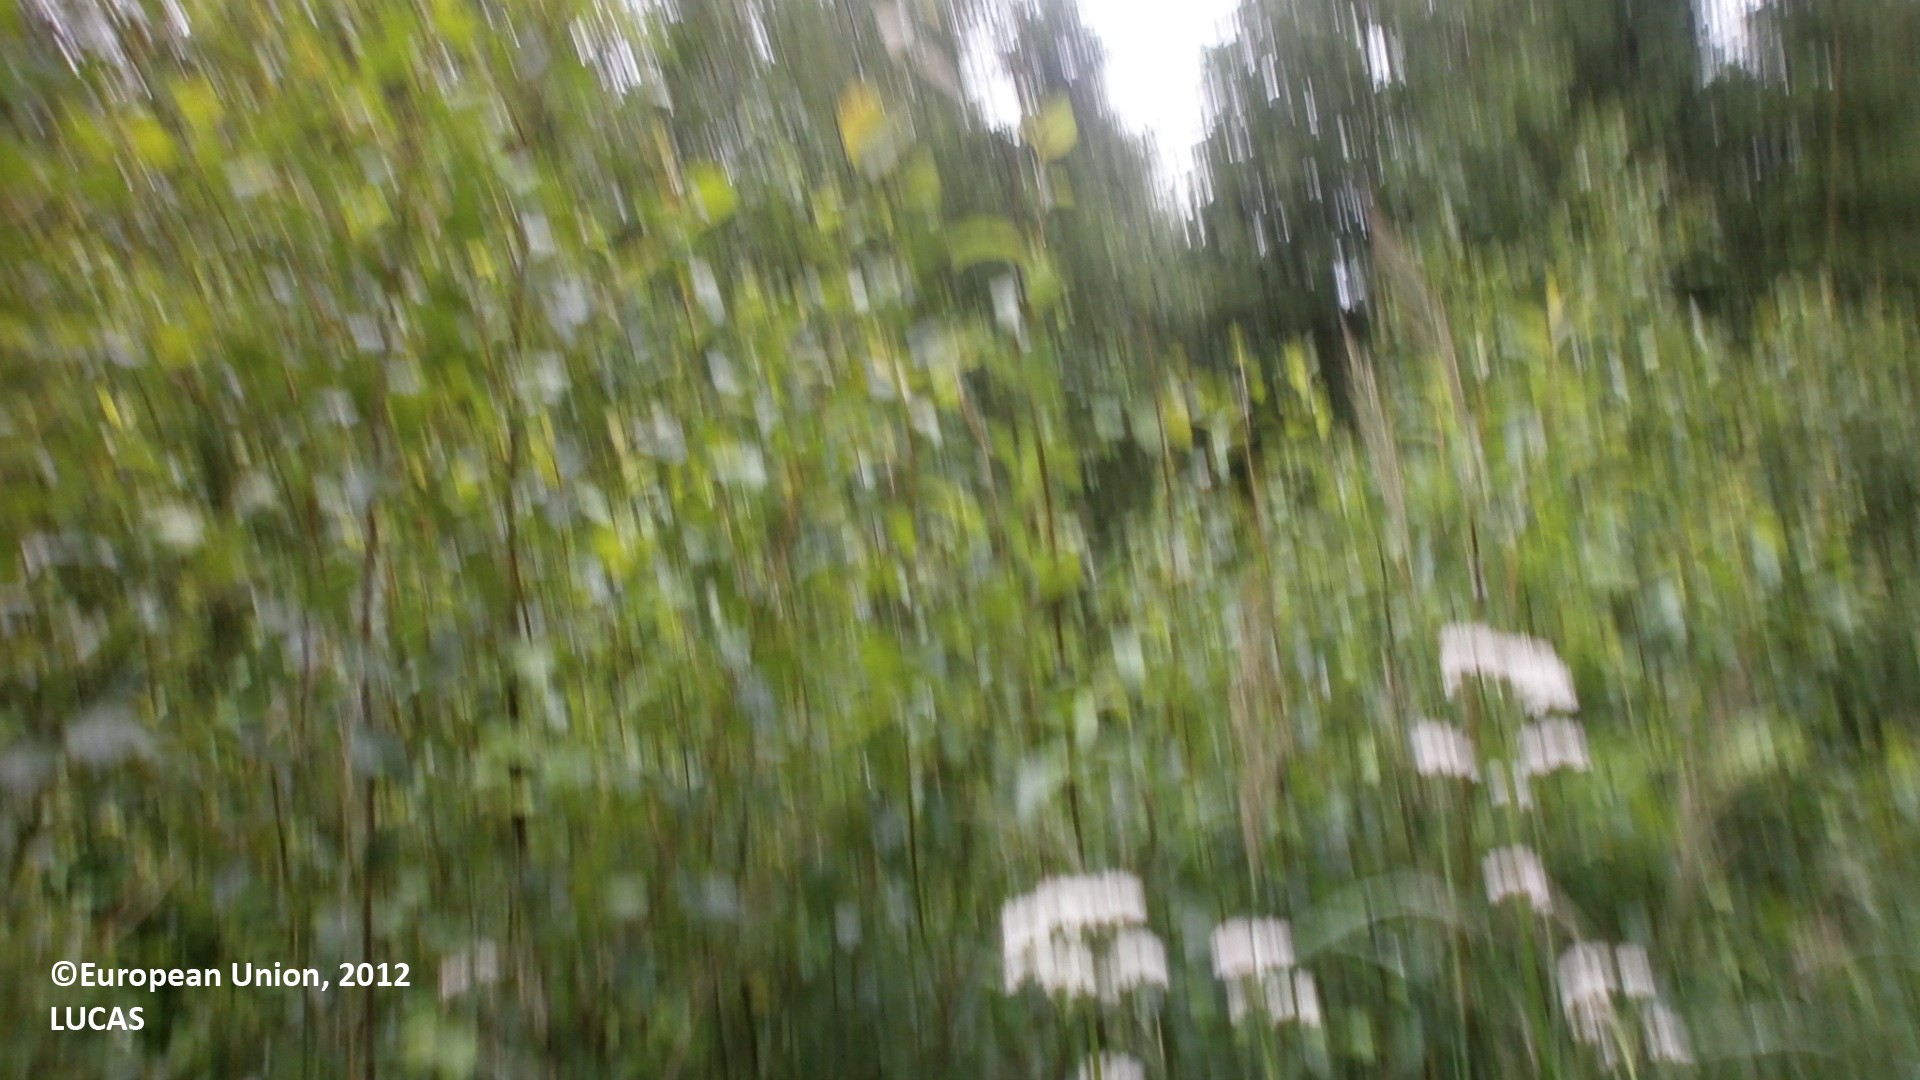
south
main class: Woodland
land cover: Broadleaved woodland
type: boreal forest
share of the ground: 50 - 75 %
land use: Energy production
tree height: < 5 m
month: July
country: FI
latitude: 64.5860
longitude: 24.5842
